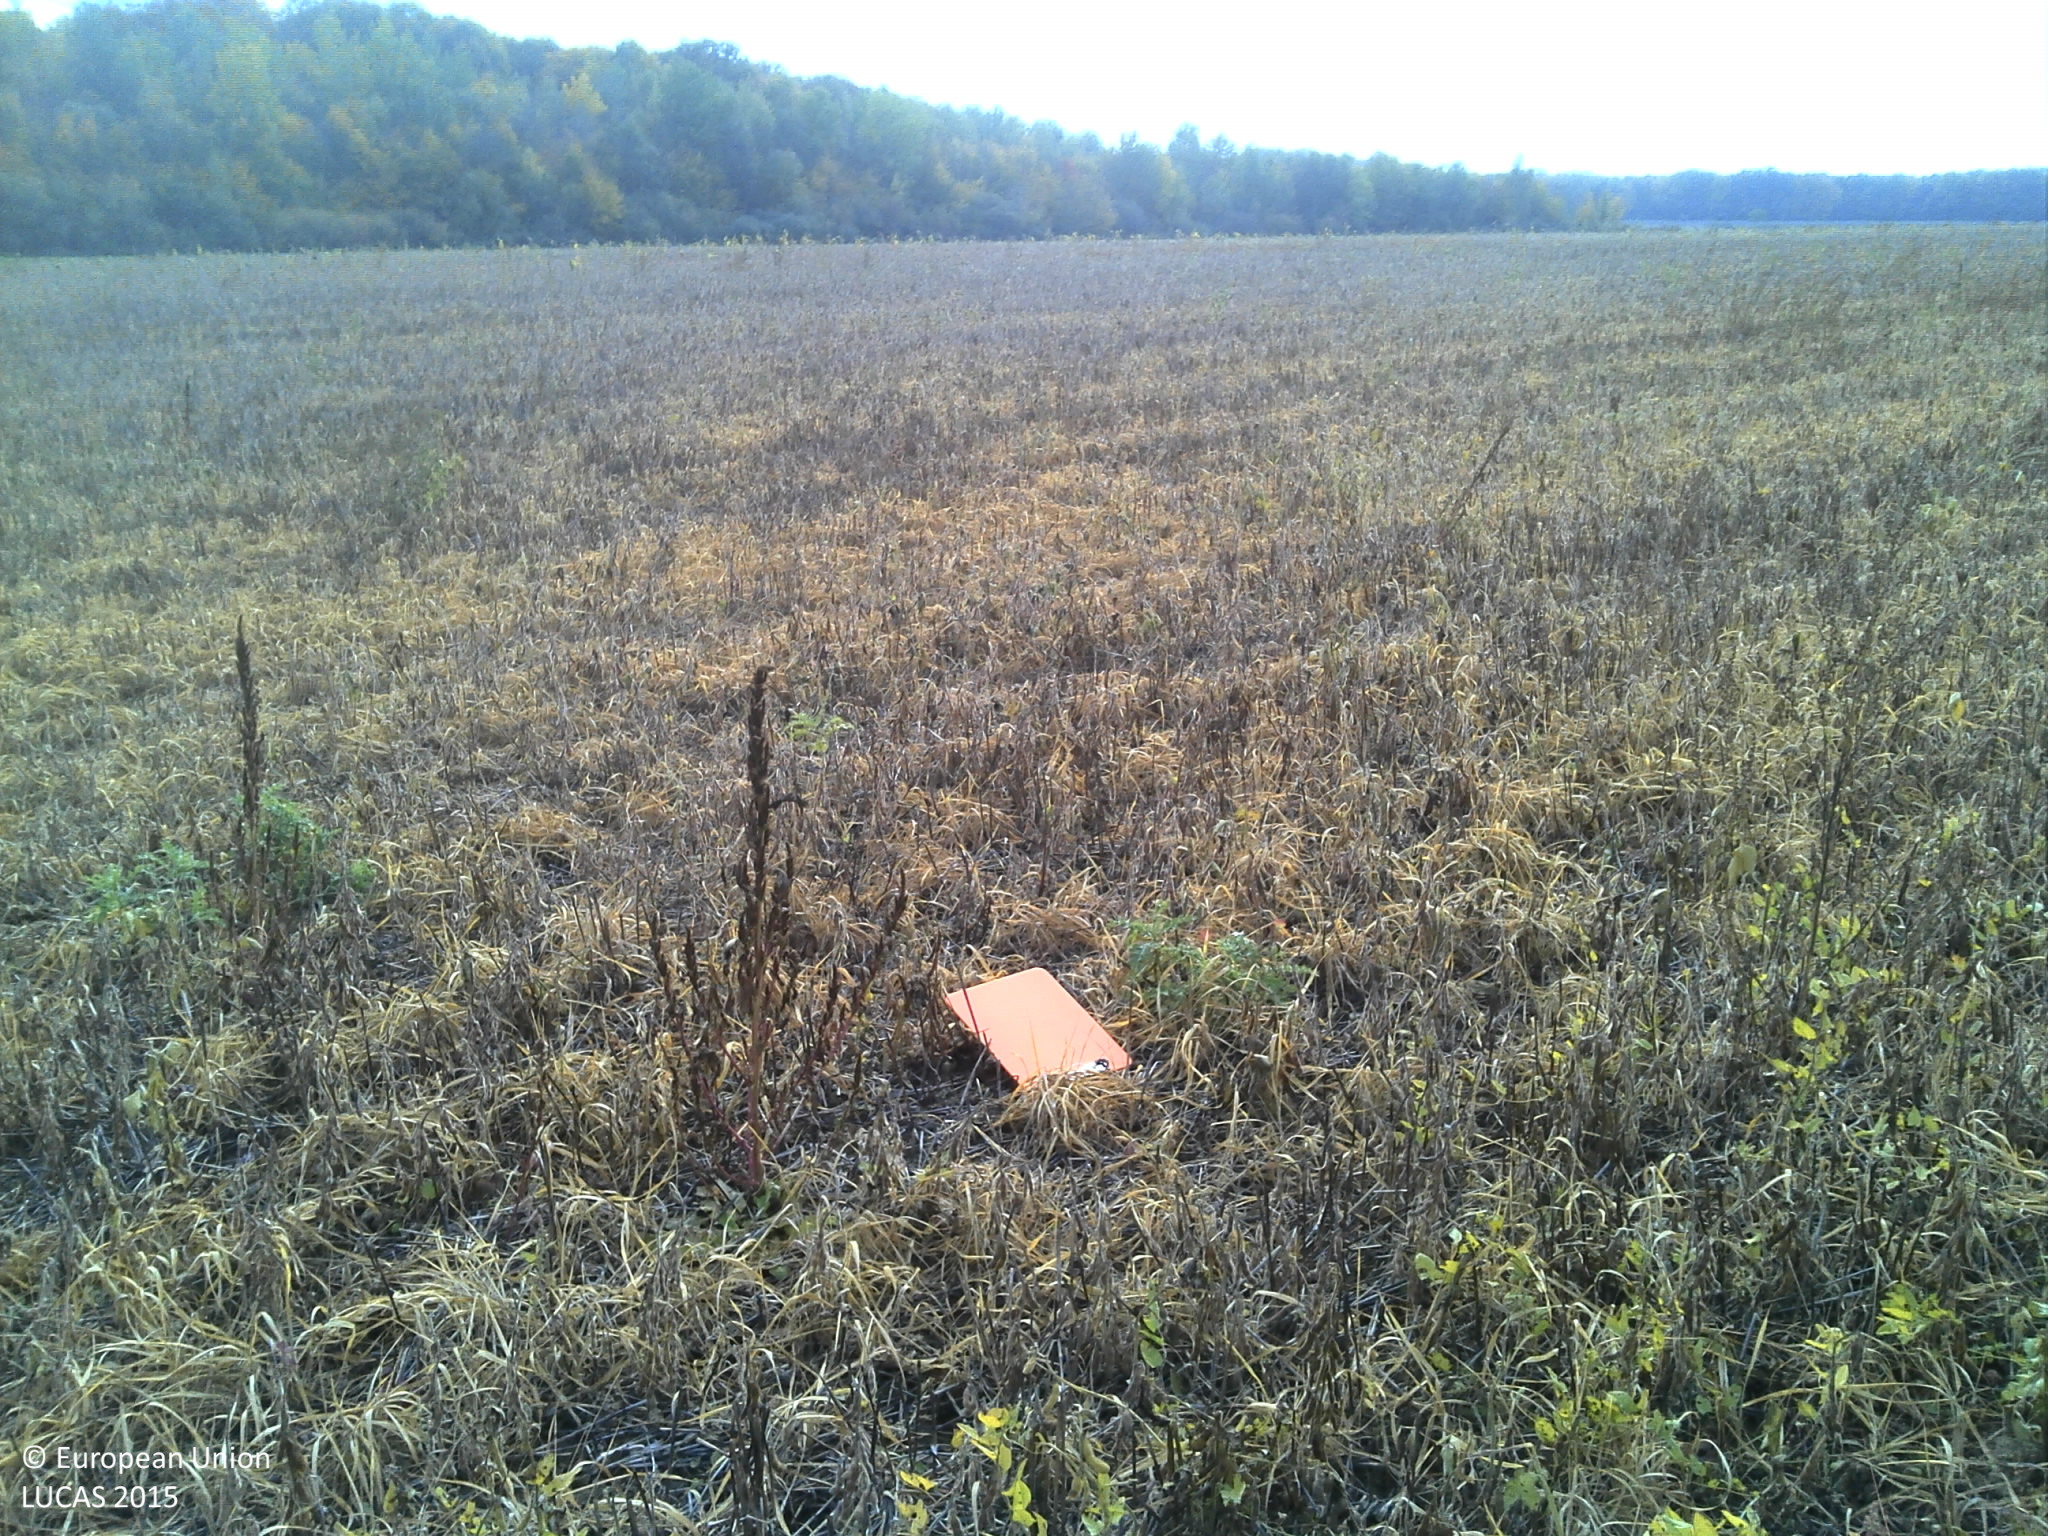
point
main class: Cropland
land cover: Common wheat
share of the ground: 50 - 75 %
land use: Agriculture (excluding fallow land and kitchen gardens)
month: October
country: FR
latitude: 47.0776
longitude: 5.2996
